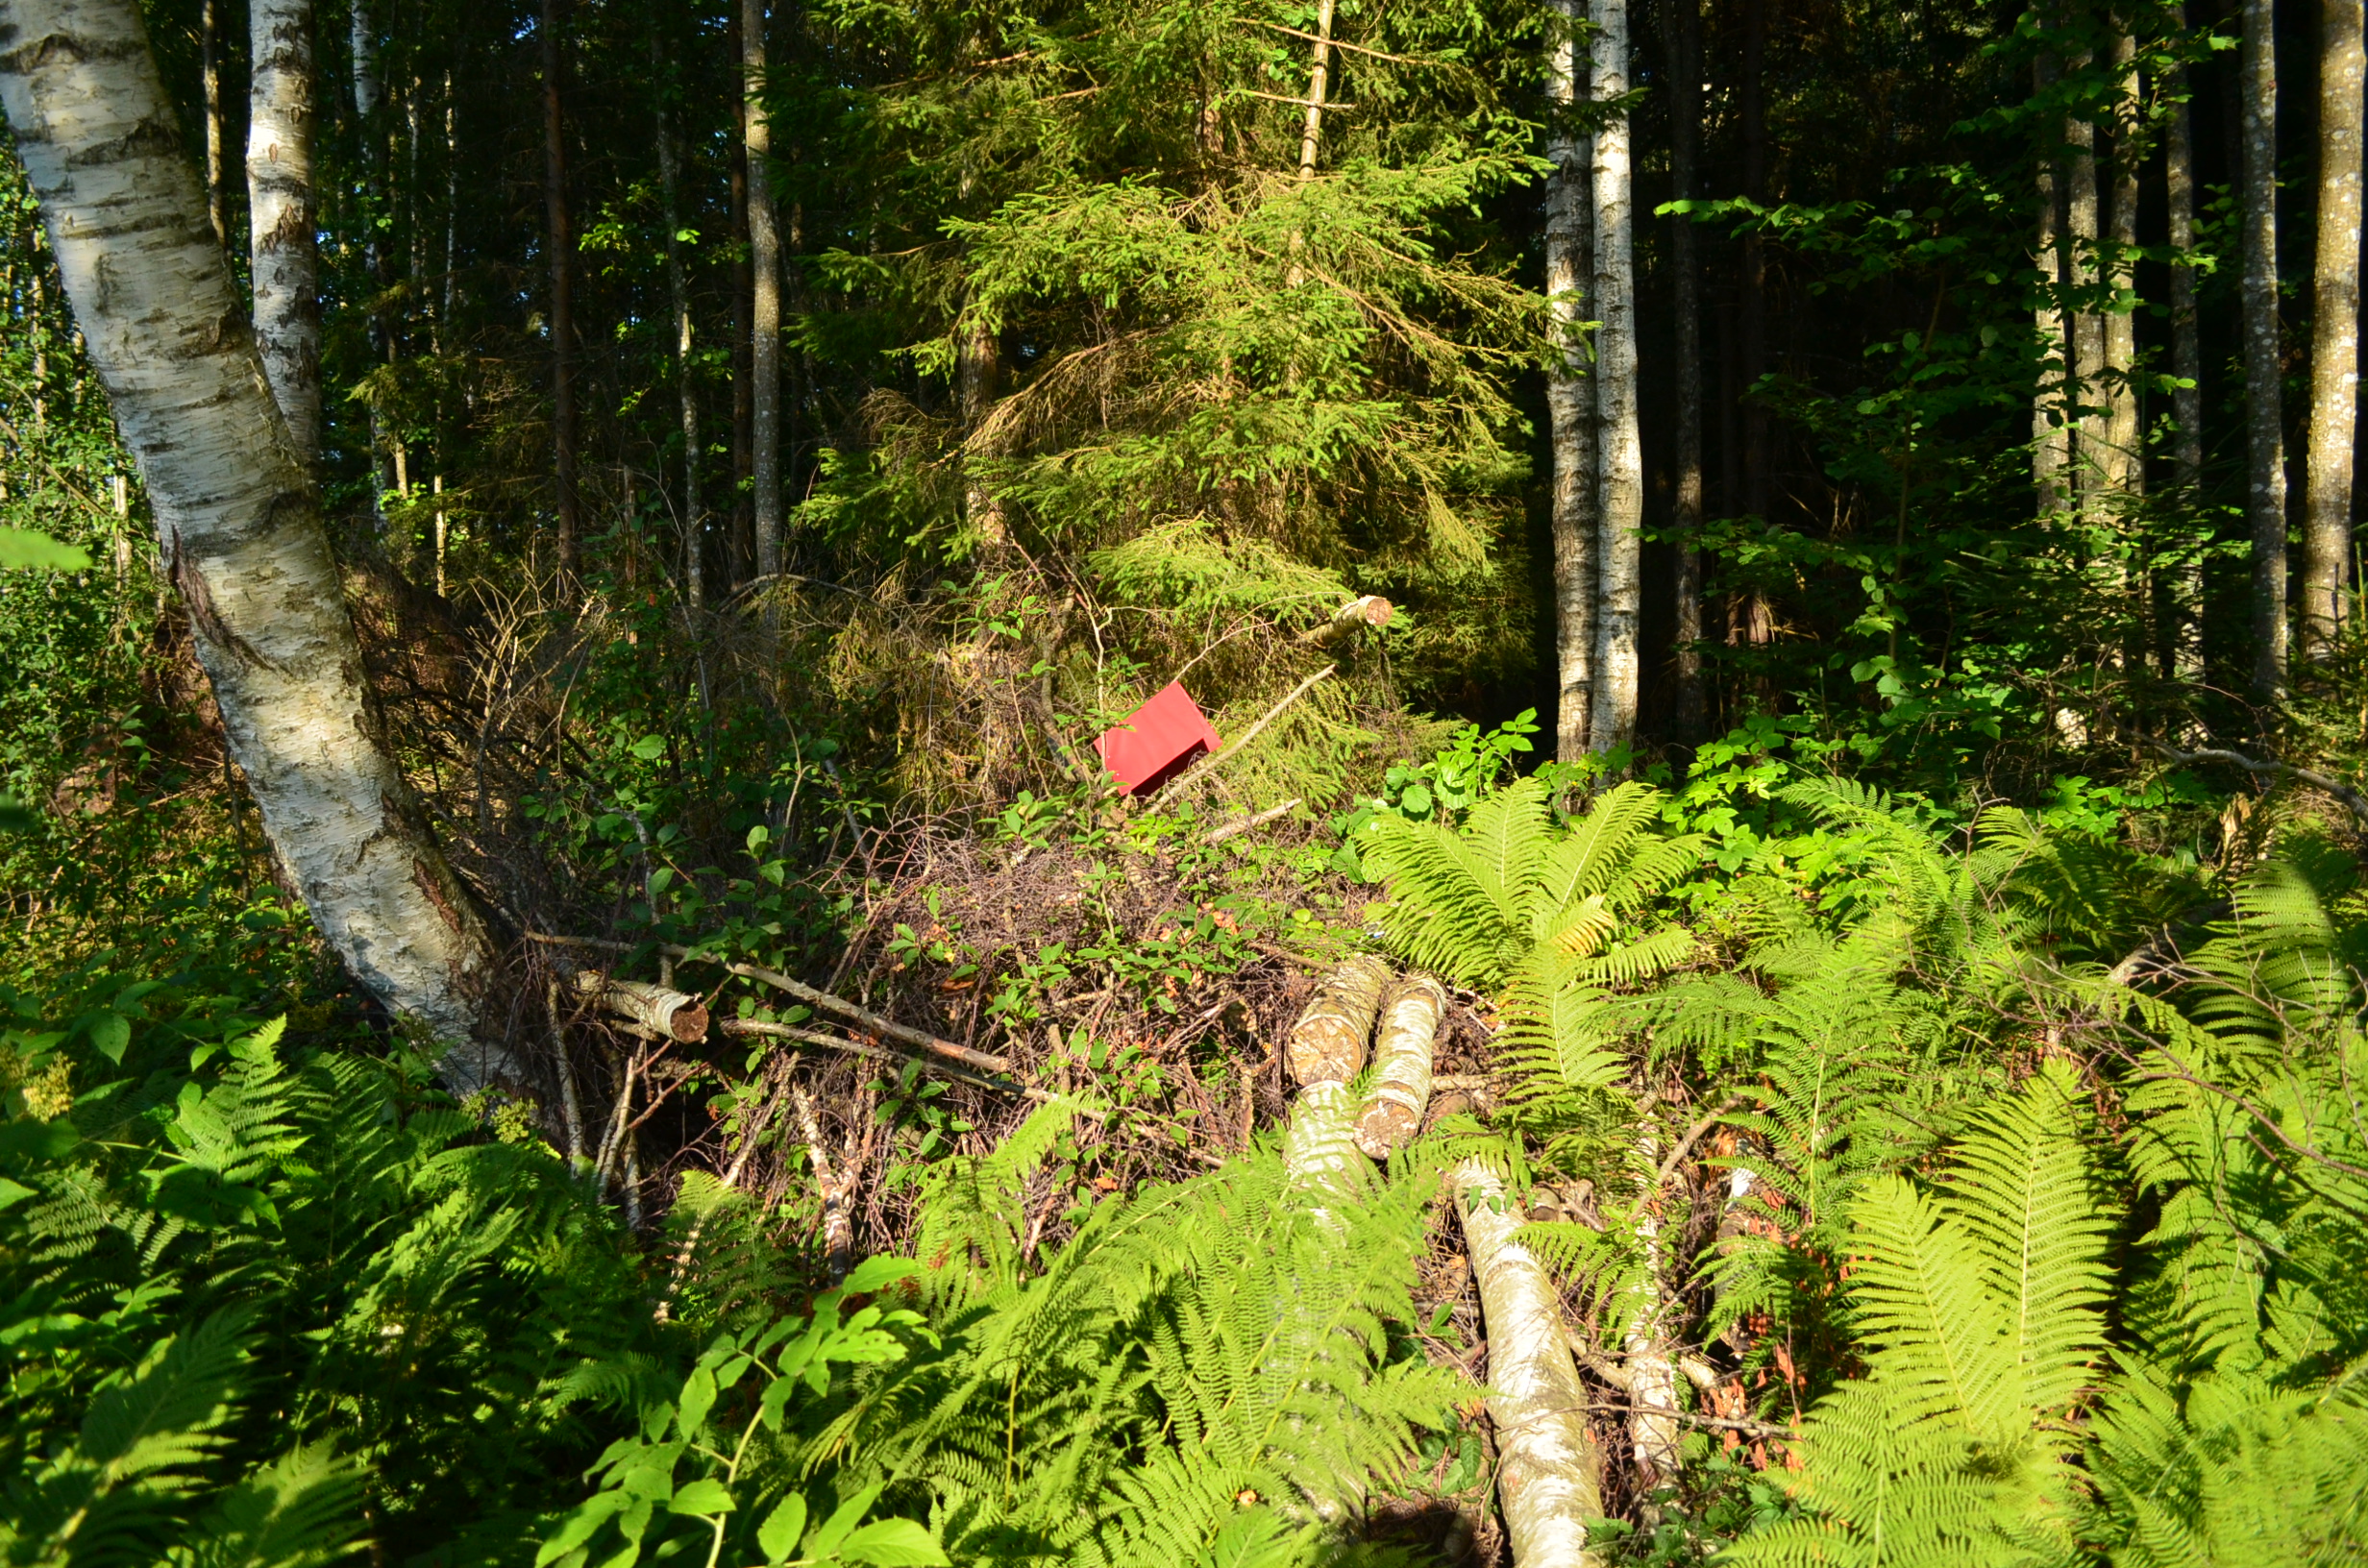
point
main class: Woodland
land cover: Spruce dominated mixed woodland
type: hemiboreal forest and nemoral coniferous forest and mixed broadleaved-coniferous forest
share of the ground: 50 - 75 %
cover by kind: broadleaved forest trees 30 %, coniferous forest trees 25 %, herbaceous plants 25 %, shrubs 20 %
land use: Forestry
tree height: > 5 m
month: August
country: LV
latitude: 57.6198
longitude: 22.2533
